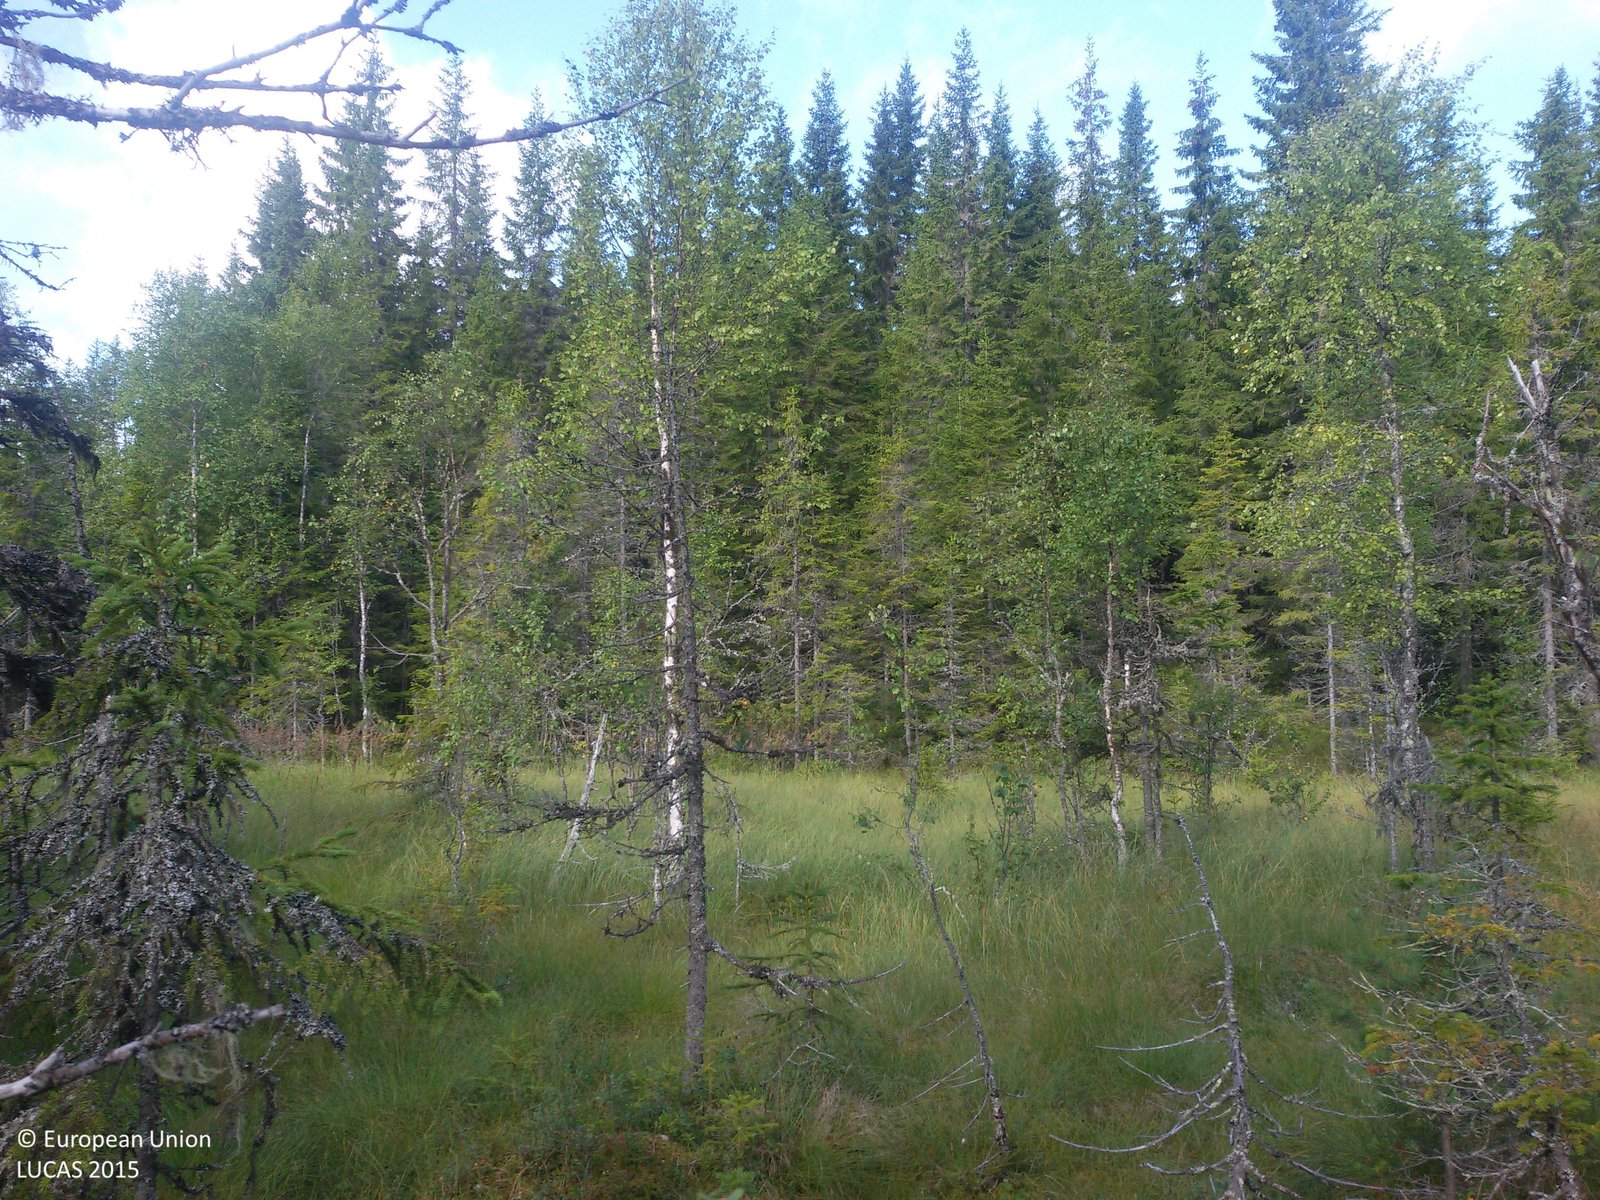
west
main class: Woodland
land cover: Spruce dominated coniferous woodland
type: mire and swamp forests
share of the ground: 50 - 75 %
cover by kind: coniferous forest trees 60 %, herbaceous plants 35 %, broadleaved forest trees 5 %
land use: Forestry
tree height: > 5 m
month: August
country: SE
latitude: 60.9194
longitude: 16.0175
